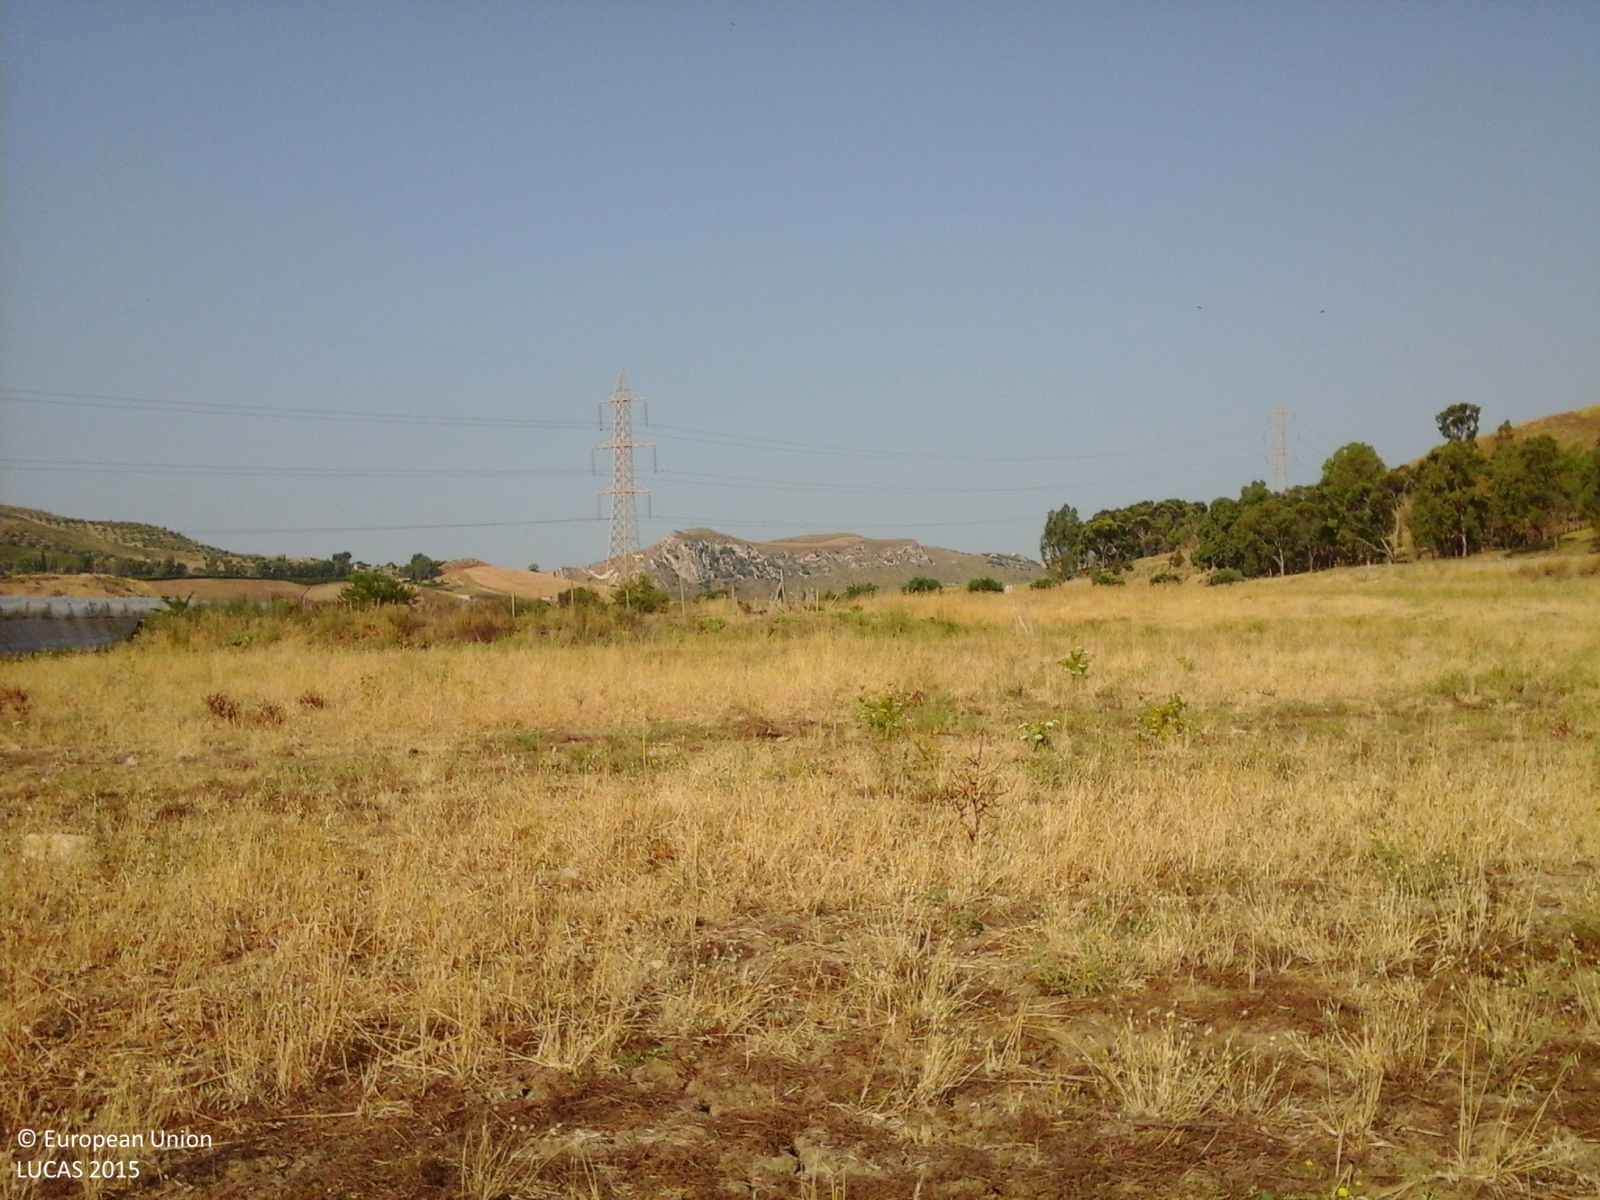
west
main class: Grassland
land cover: Spontaneously vegetated surfaces
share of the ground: > 75 %
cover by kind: herbaceous plants 100 %
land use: Agriculture (excluding fallow land and kitchen gardens)
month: July
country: IT
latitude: 37.1749
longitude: 13.9448
